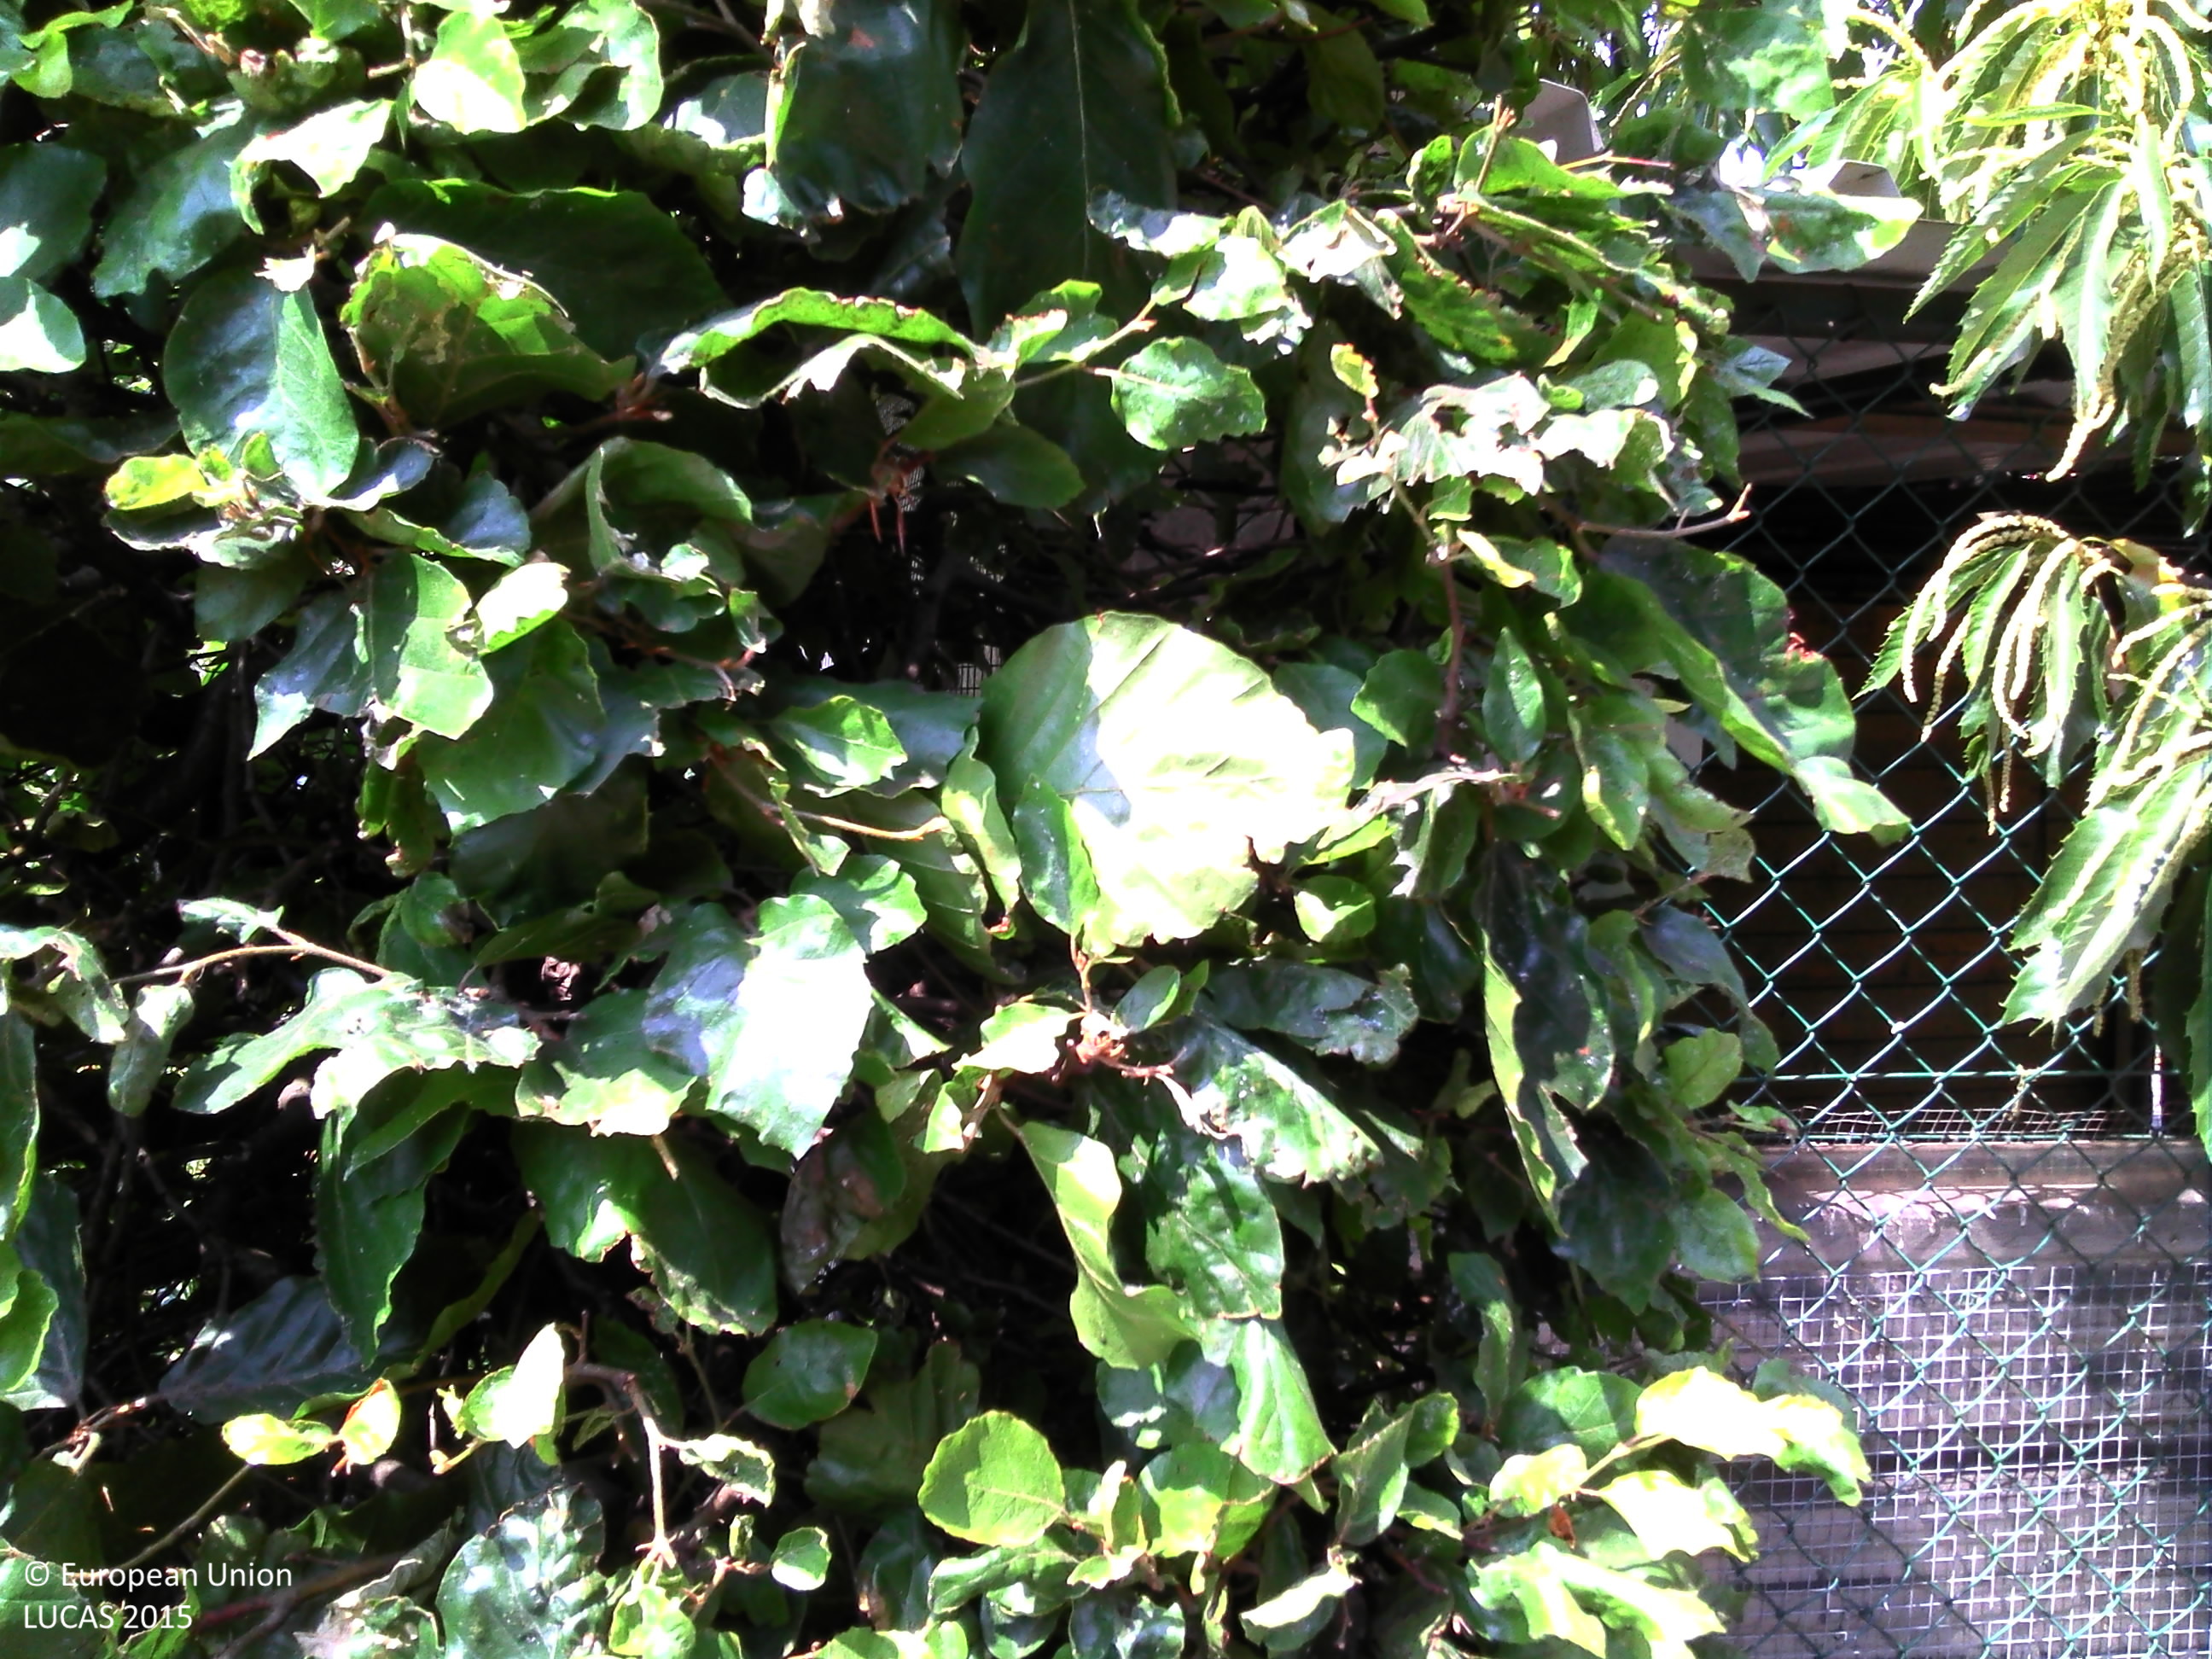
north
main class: Grassland
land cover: Grassland with sparse tree/shrub cover
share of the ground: > 75 %
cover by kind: herbaceous plants 95 %, broadleaved forest trees 5 %
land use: Residential
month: July
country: BE
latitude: 50.9772
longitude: 5.4832
